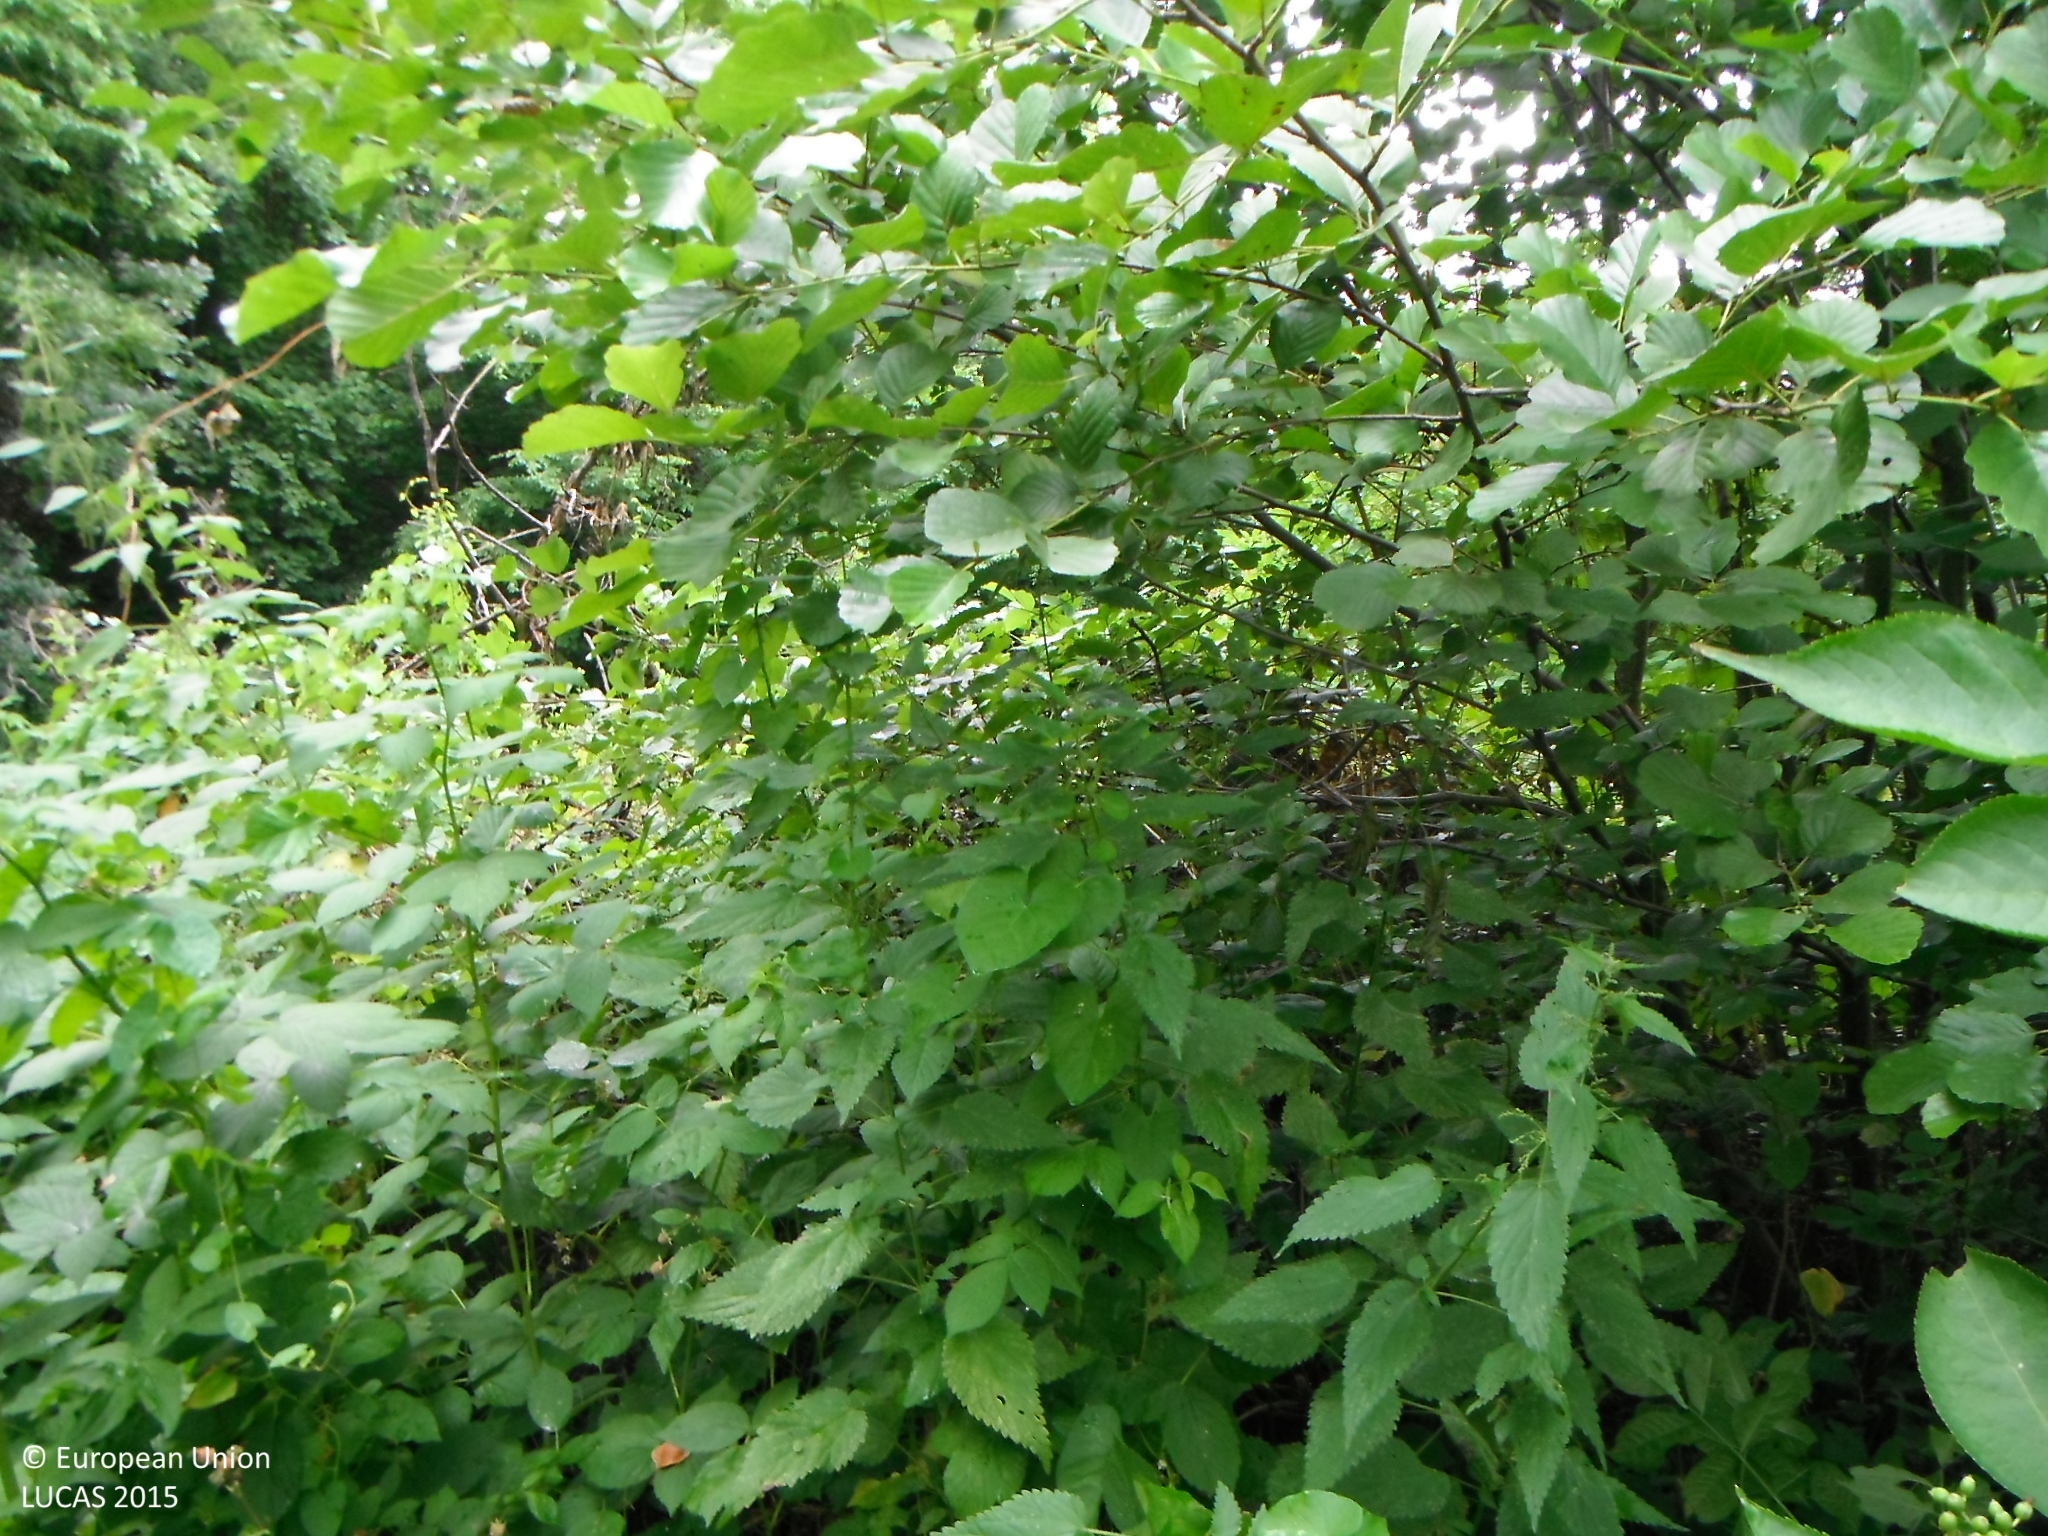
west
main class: Woodland
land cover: Broadleaved woodland
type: floodplain forest
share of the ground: > 75 %
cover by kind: broadleaved forest trees 80 %, shrubs 20 %
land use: Forestry
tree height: > 5 m
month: July
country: SK
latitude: 48.3755
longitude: 19.0526
